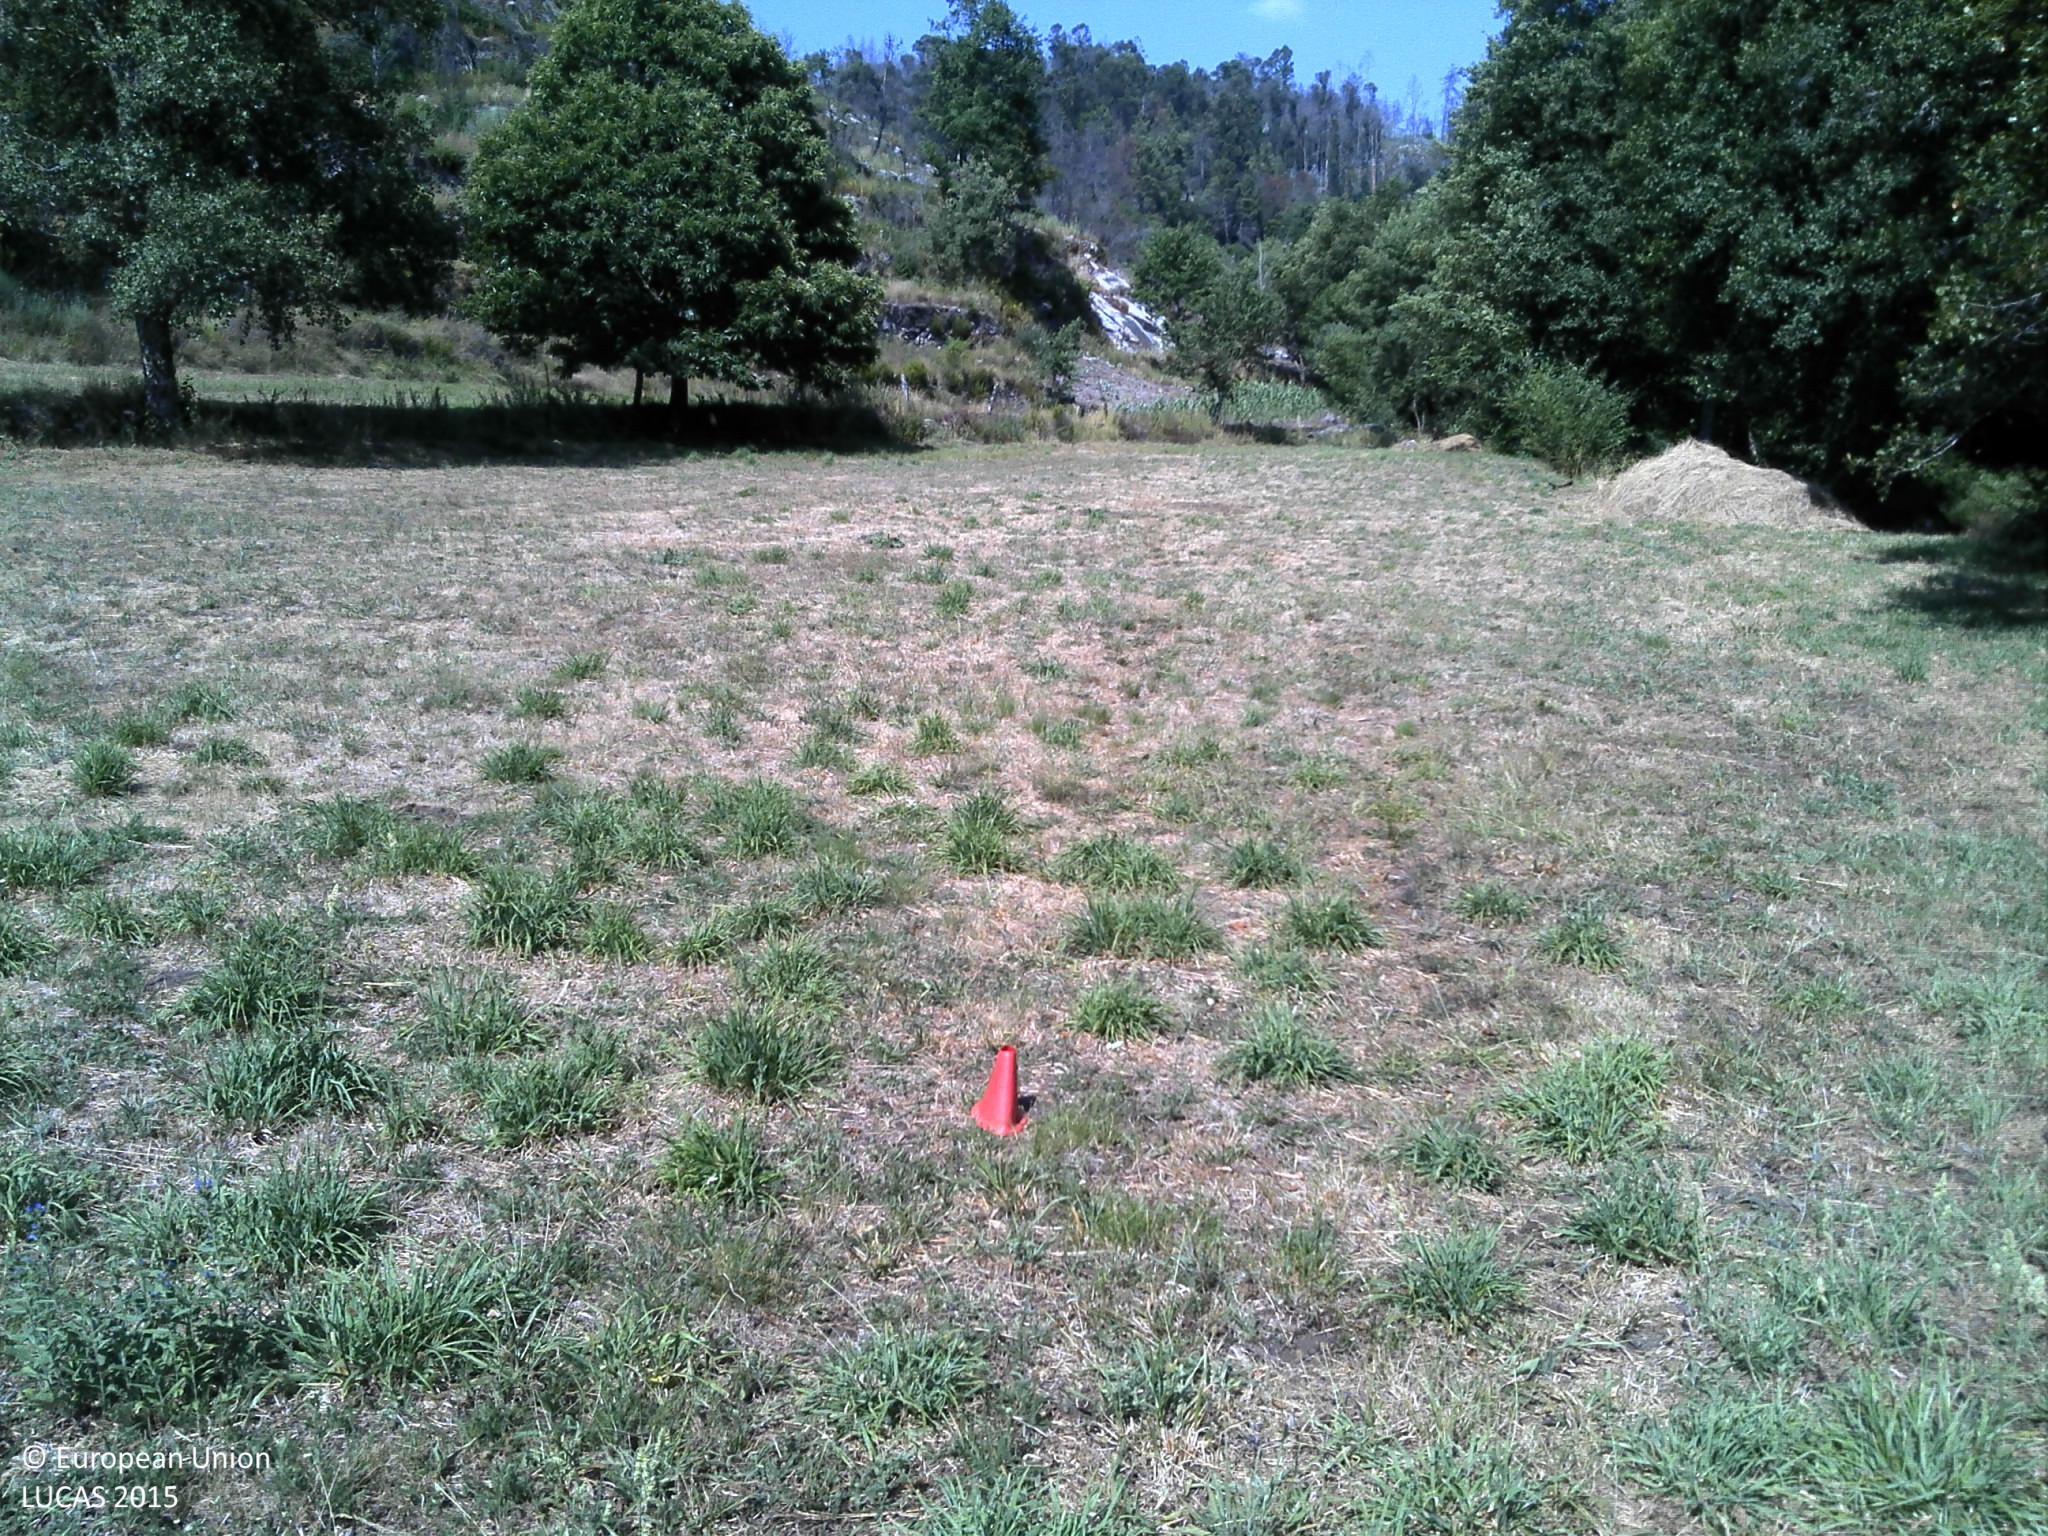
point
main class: Grassland
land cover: Grassland without tree/shrub cover
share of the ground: > 75 %
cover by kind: herbaceous plants 100 %
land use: Agriculture (excluding fallow land and kitchen gardens)
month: July
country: PT
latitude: 40.9053
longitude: -7.8511
